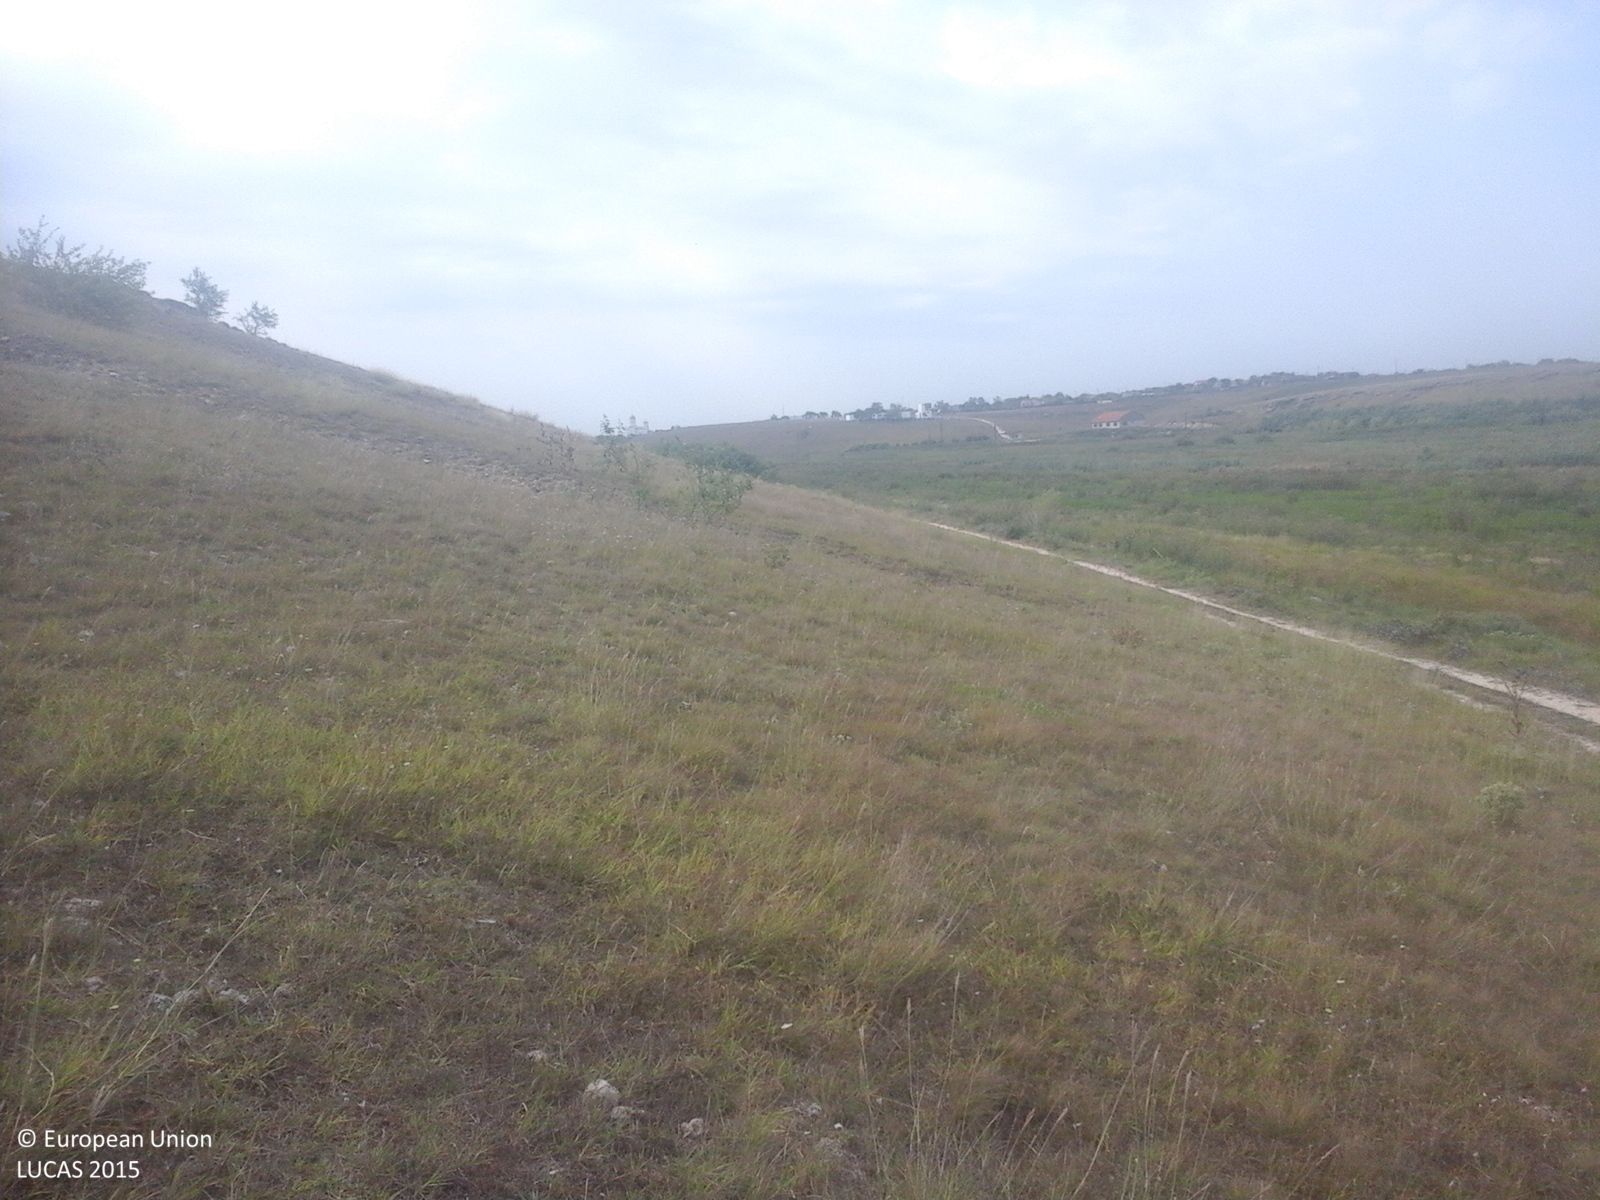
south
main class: Grassland
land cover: Grassland without tree/shrub cover
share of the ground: > 75 %
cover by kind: herbaceous plants 100 %
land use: Agriculture (excluding fallow land and kitchen gardens)
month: August
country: RO
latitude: 43.9623
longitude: 28.1912
